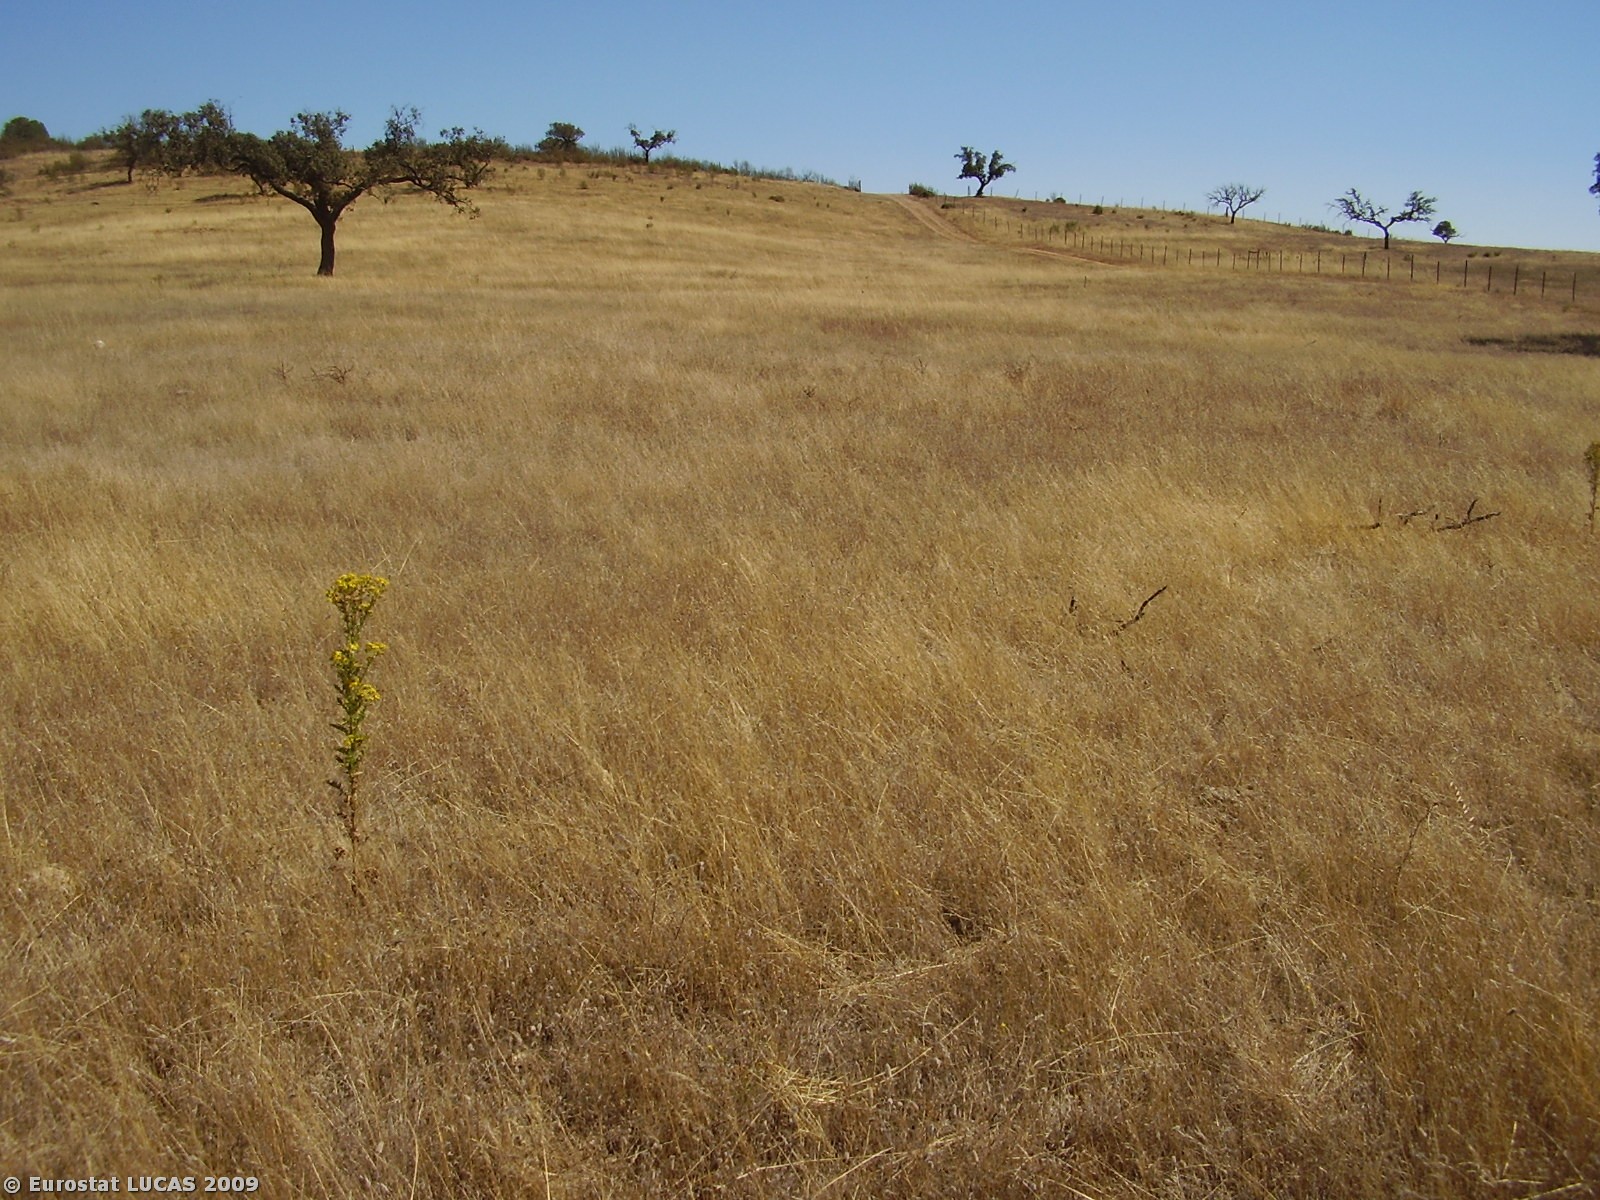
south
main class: Grassland
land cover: Grassland without tree/shrub cover
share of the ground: > 75 %
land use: Fallow land
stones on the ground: 25 - 50 %
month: July
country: PT
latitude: 37.8834
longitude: -7.5155
